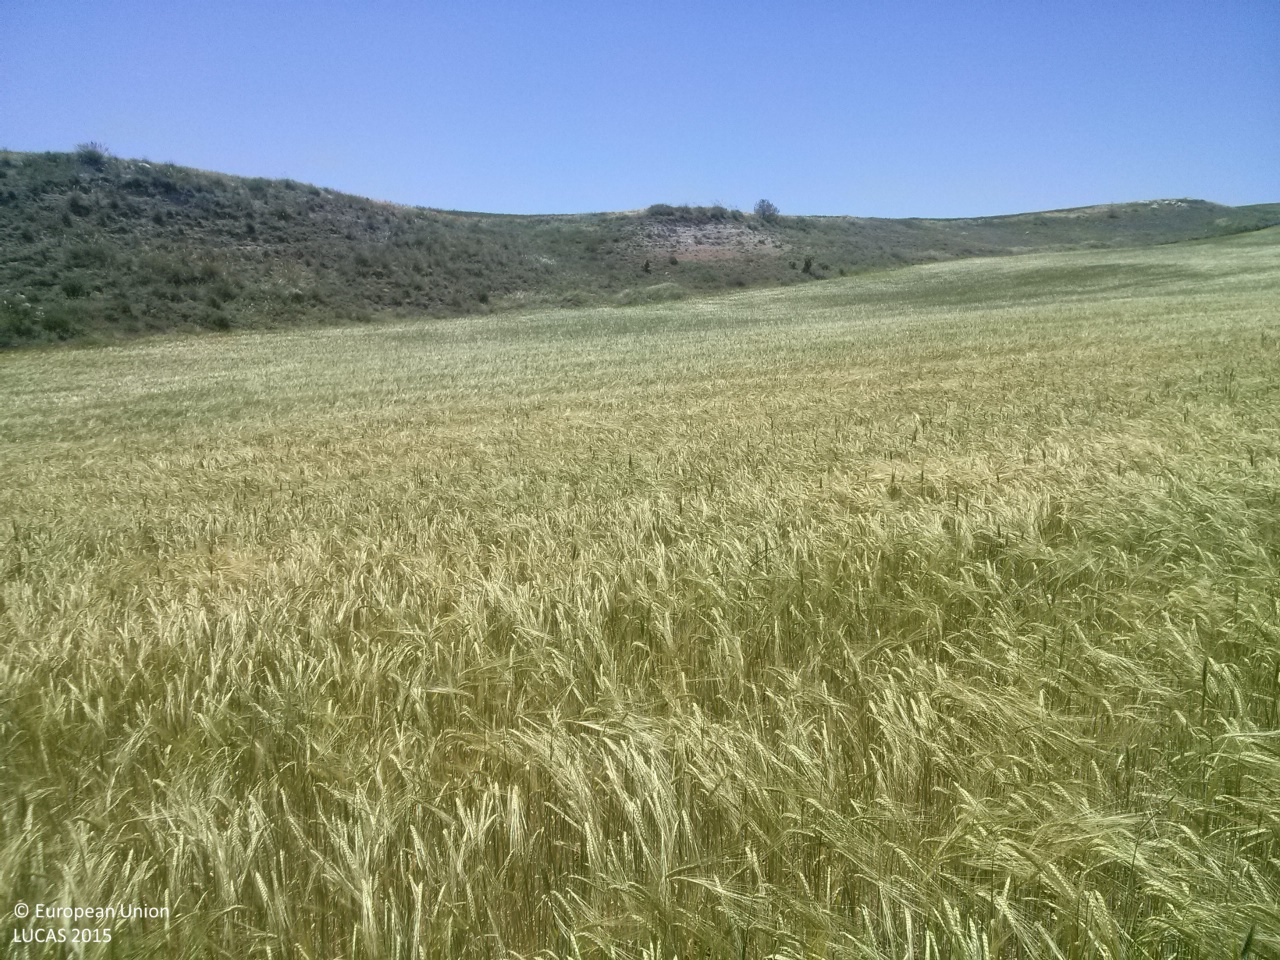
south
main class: Cropland
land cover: Barley
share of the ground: > 75 %
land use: Agriculture (excluding fallow land and kitchen gardens)
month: May
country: ES
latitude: 40.2570
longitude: -2.7337
